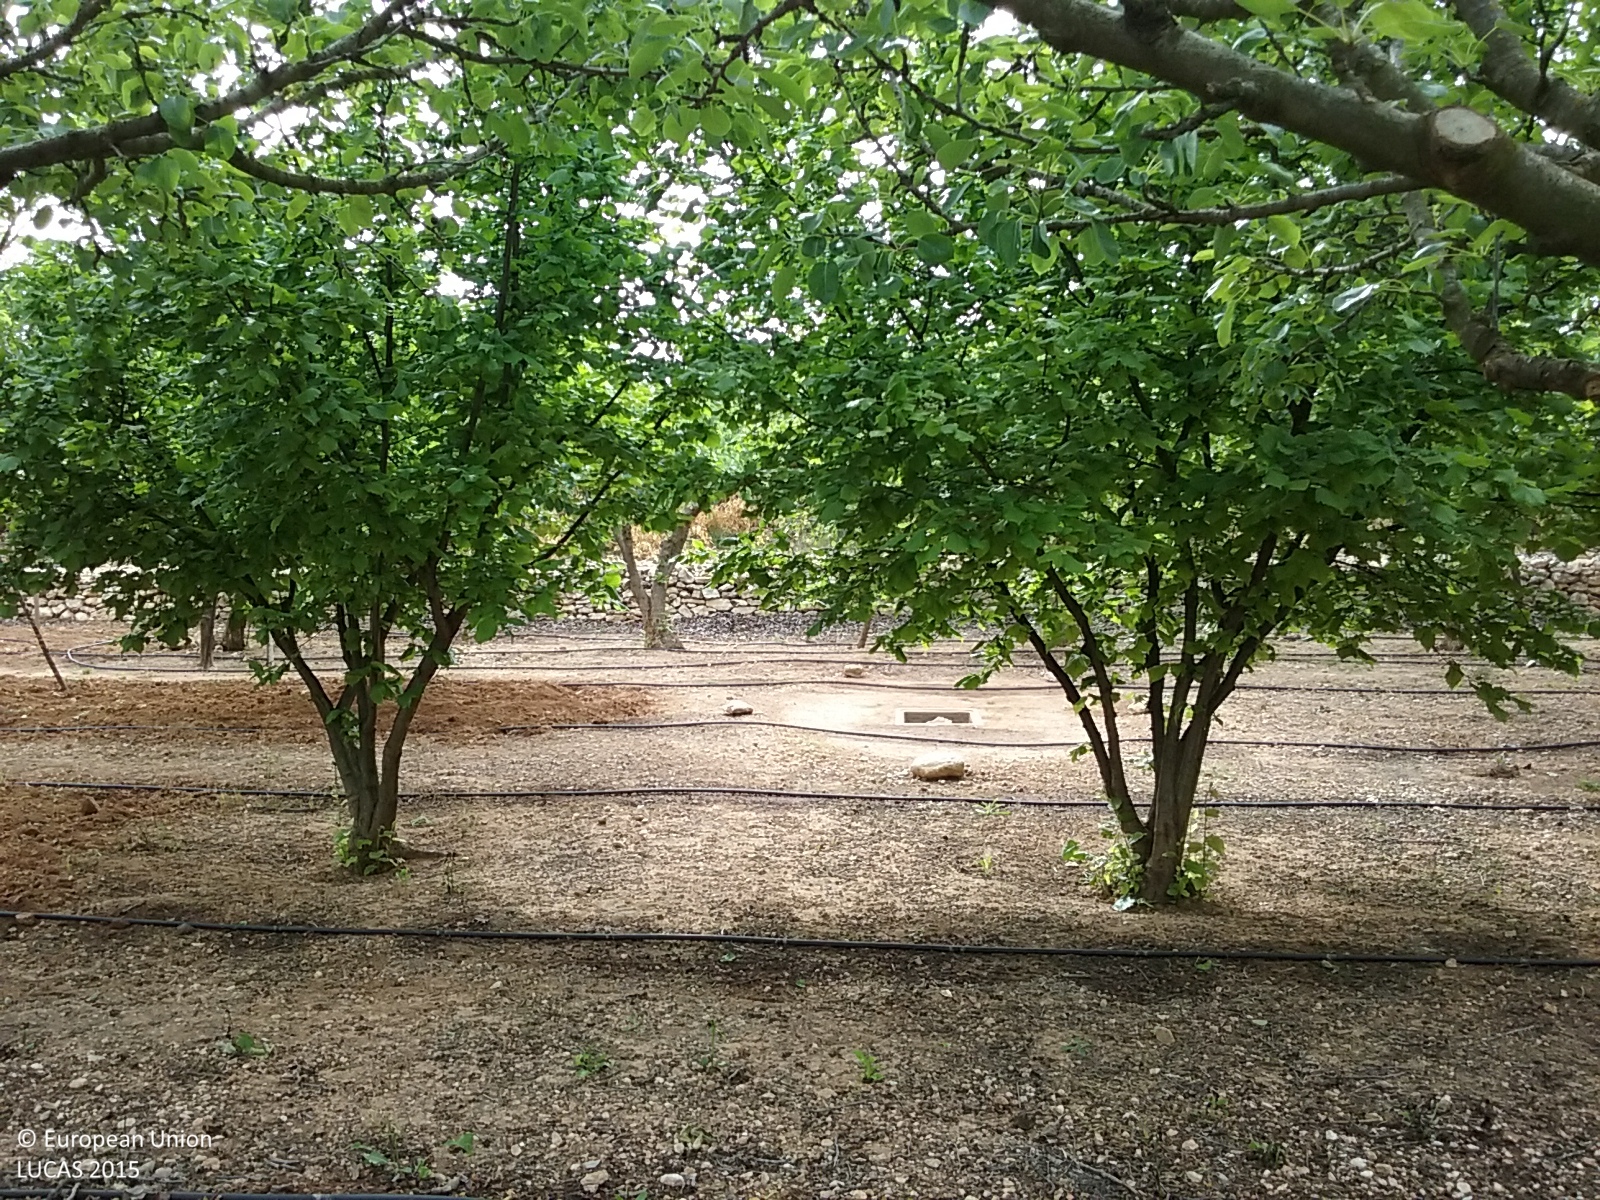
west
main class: Cropland
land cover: Cherry fruit
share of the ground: > 75 %
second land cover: Other bare soil
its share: > 75 %
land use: Agriculture (excluding fallow land and kitchen gardens)
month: May
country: ES
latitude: 40.4451
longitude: 0.3402
